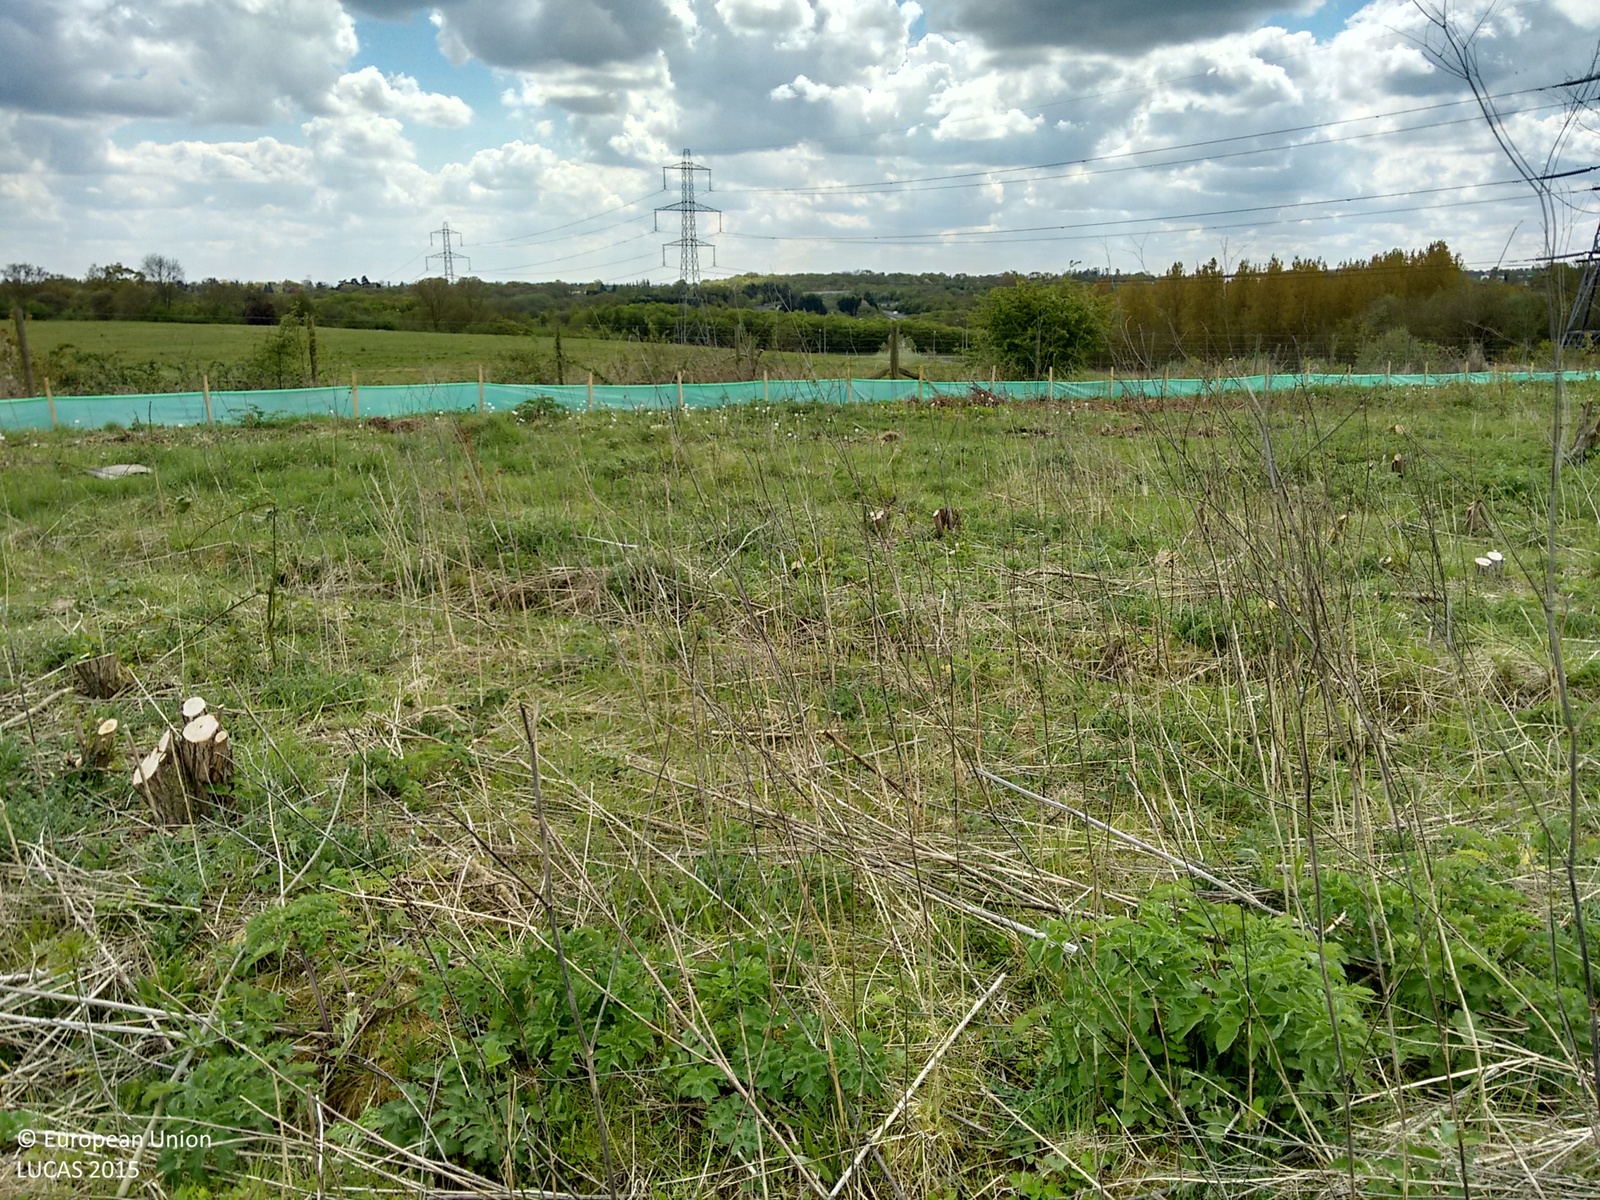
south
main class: Grassland
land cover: Grassland without tree/shrub cover
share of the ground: > 75 %
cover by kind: herbaceous plants 100 %
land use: Agriculture (excluding fallow land and kitchen gardens)
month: April
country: GB
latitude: 51.5636
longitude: -0.5261
